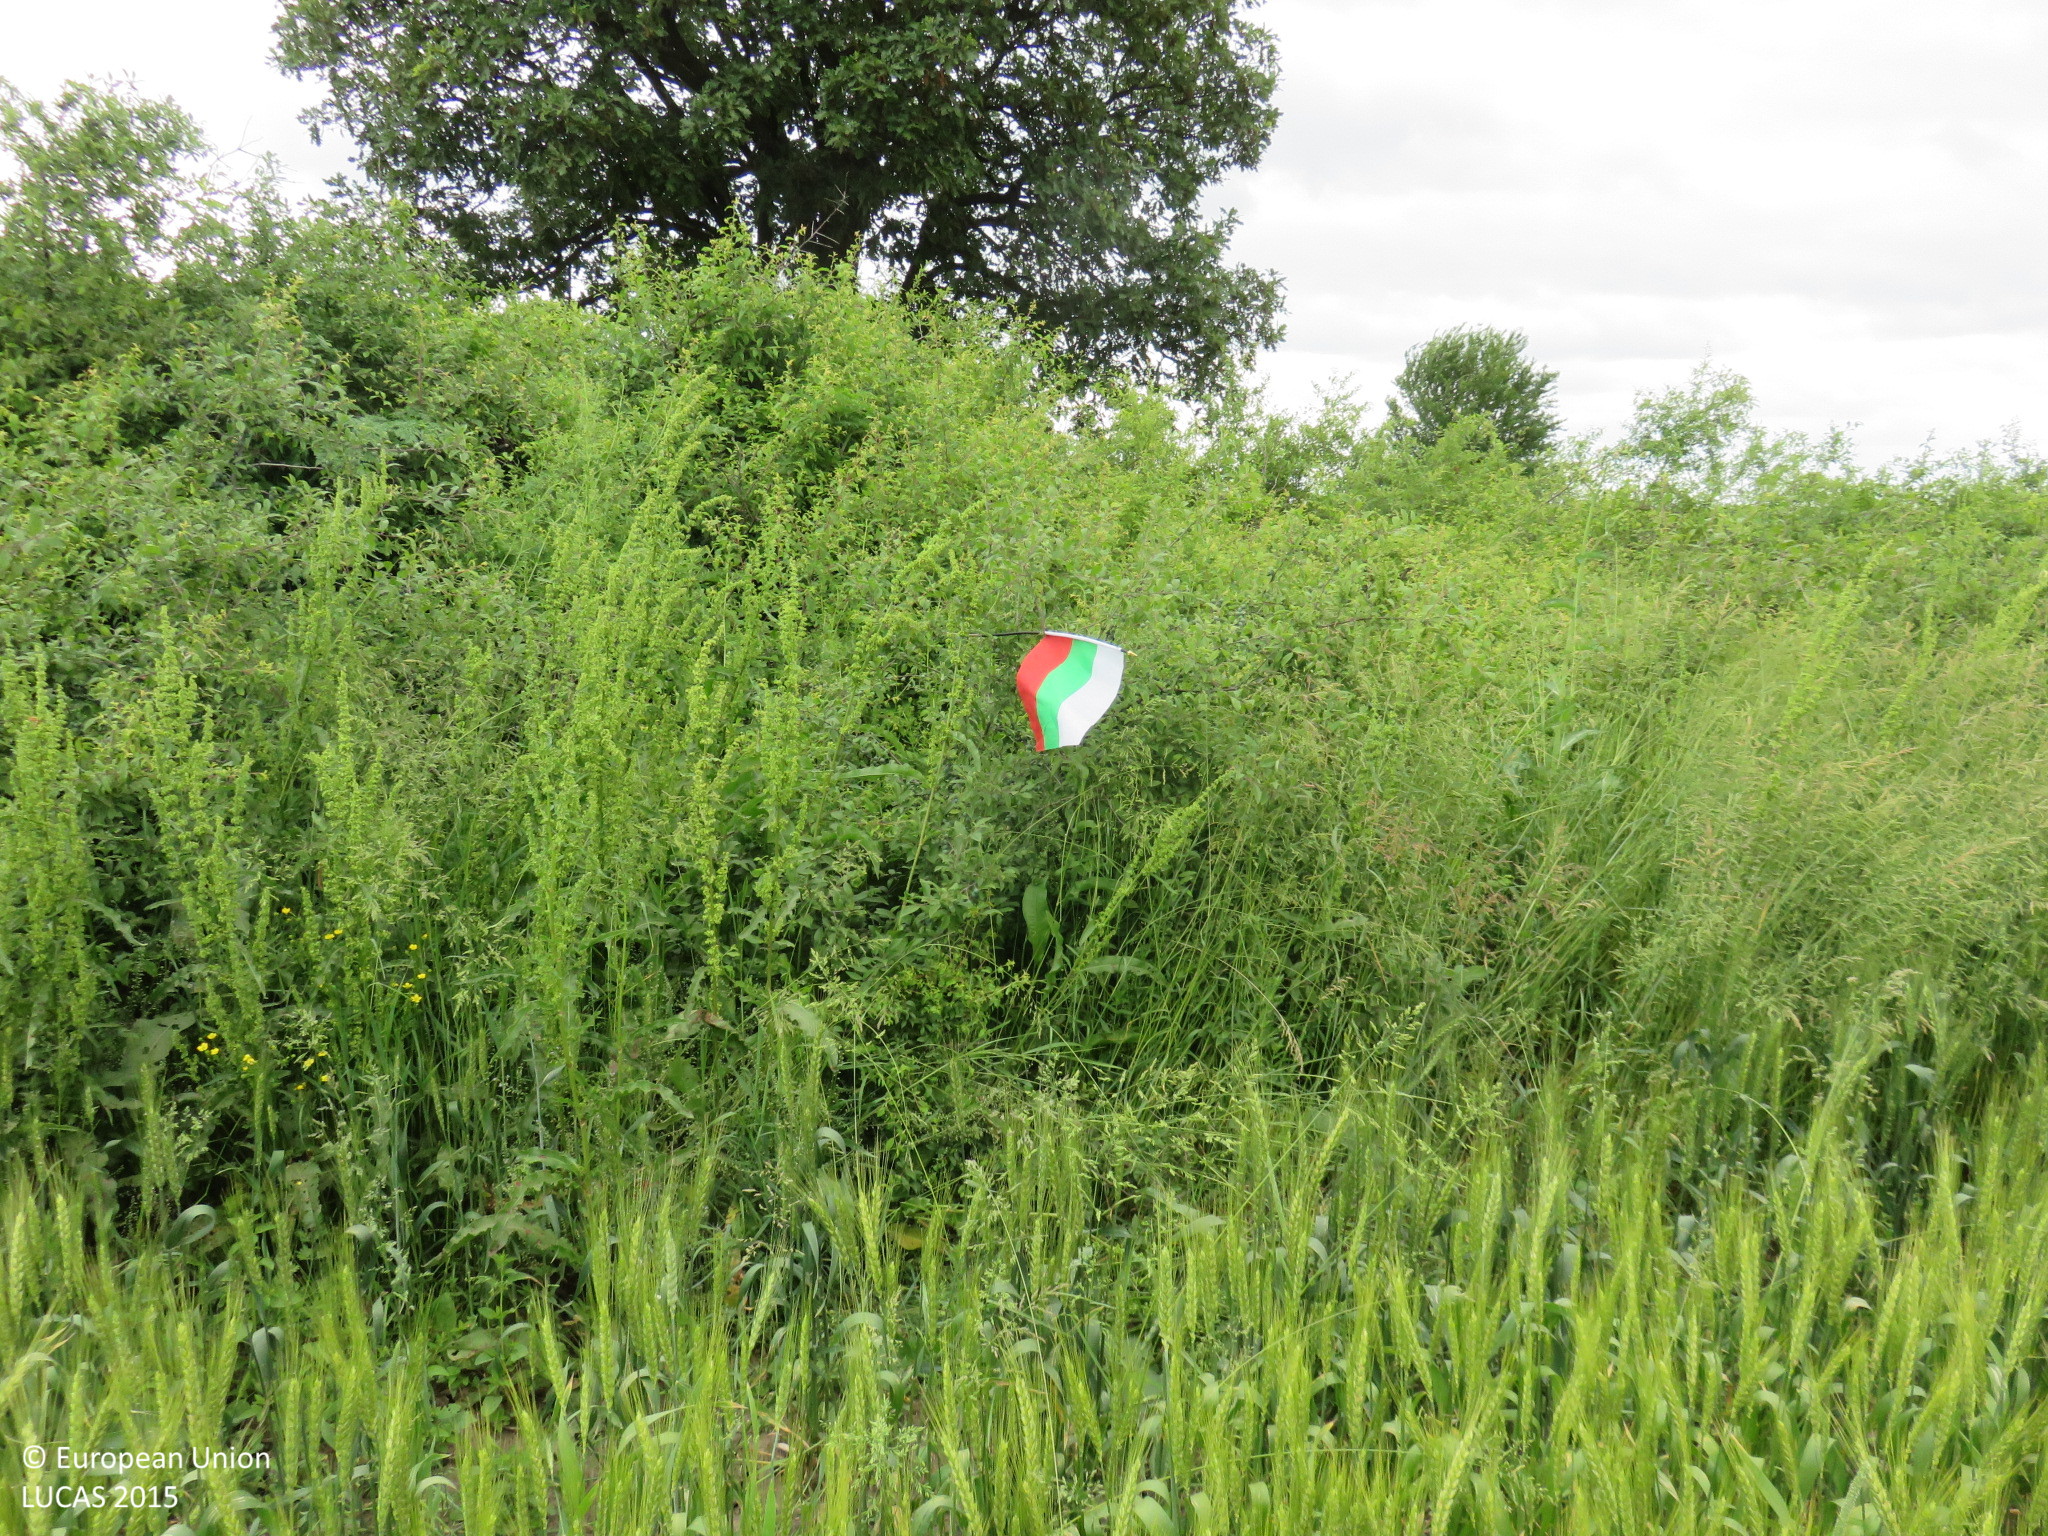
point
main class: Shrubland
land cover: Shrubland without tree cover
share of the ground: > 75 %
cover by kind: shrubs 100 %
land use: Semi-natural and natural areas not in use
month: May
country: BG
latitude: 43.2408
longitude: 24.4543
